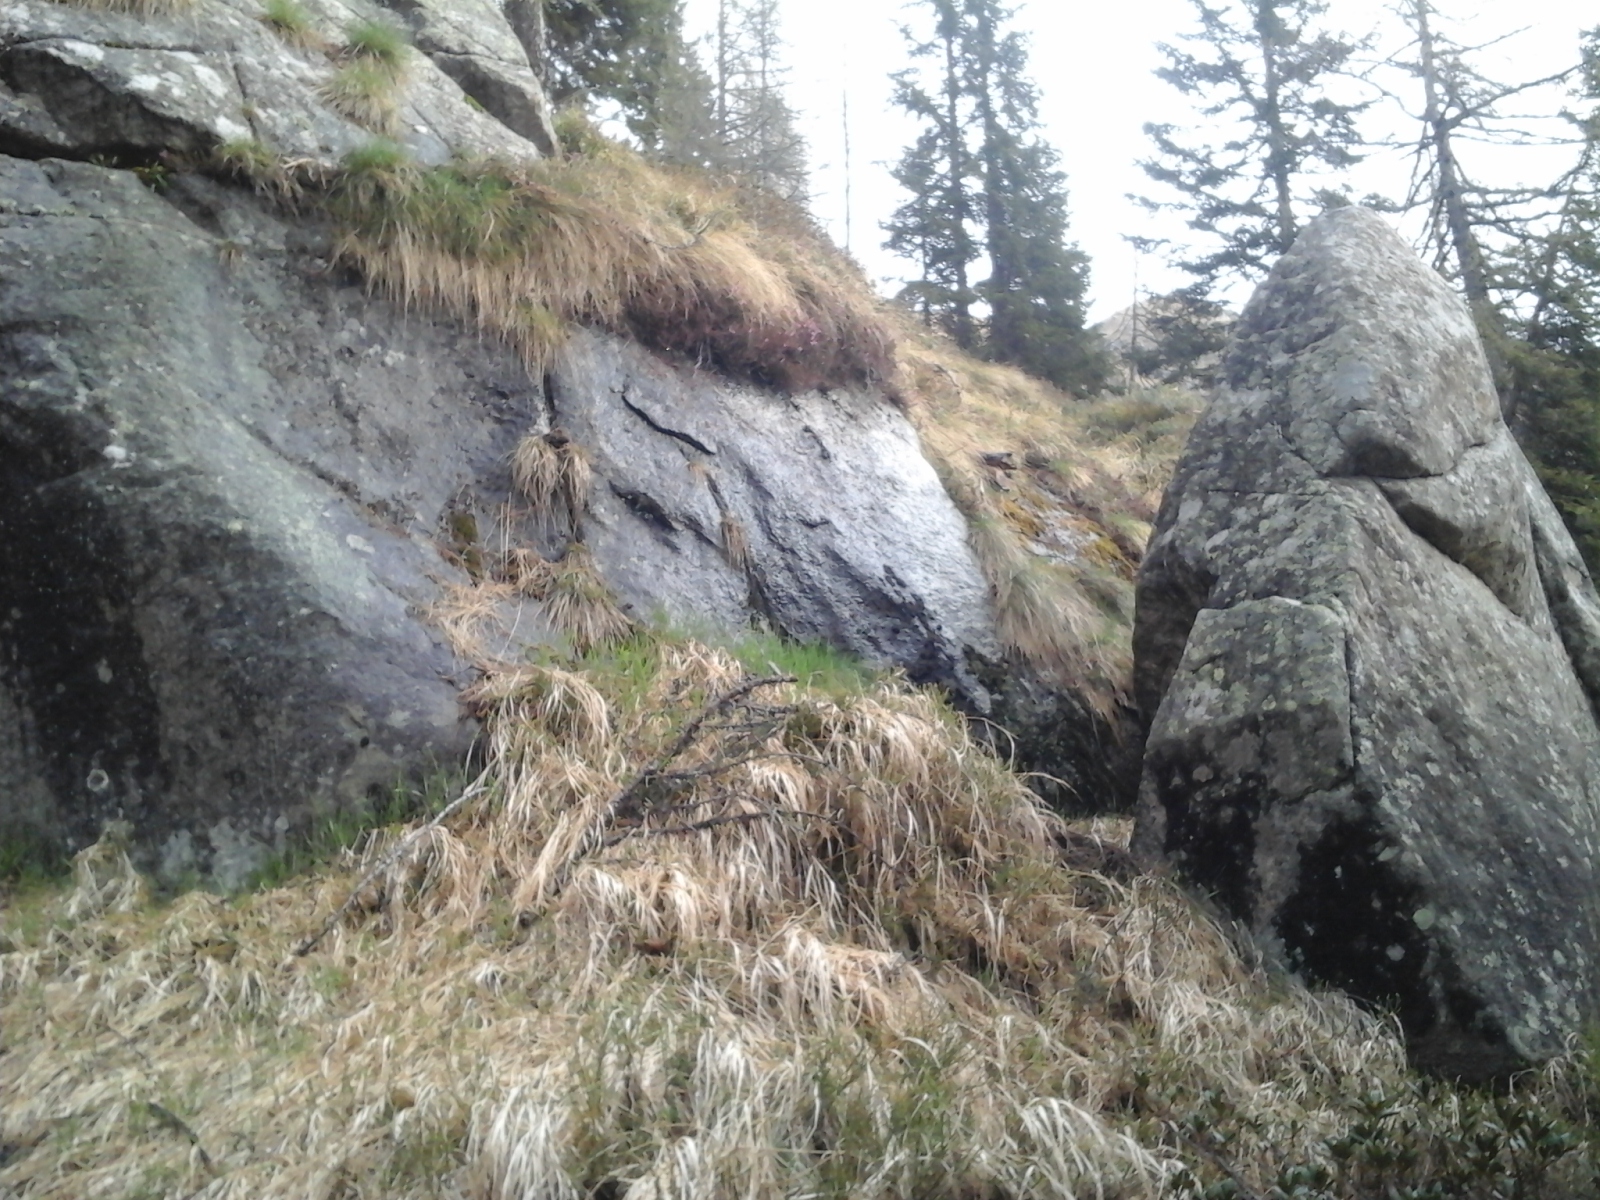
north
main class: Woodland
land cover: Other coniferous woodland
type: alpine coniferous forest
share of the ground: 25 - 50 %
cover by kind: herbaceous plants 50 %, coniferous forest trees 40 %, shrubs 10 %
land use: Forestry
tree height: > 5 m
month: May
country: IT
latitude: 46.2045
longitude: 10.7377
